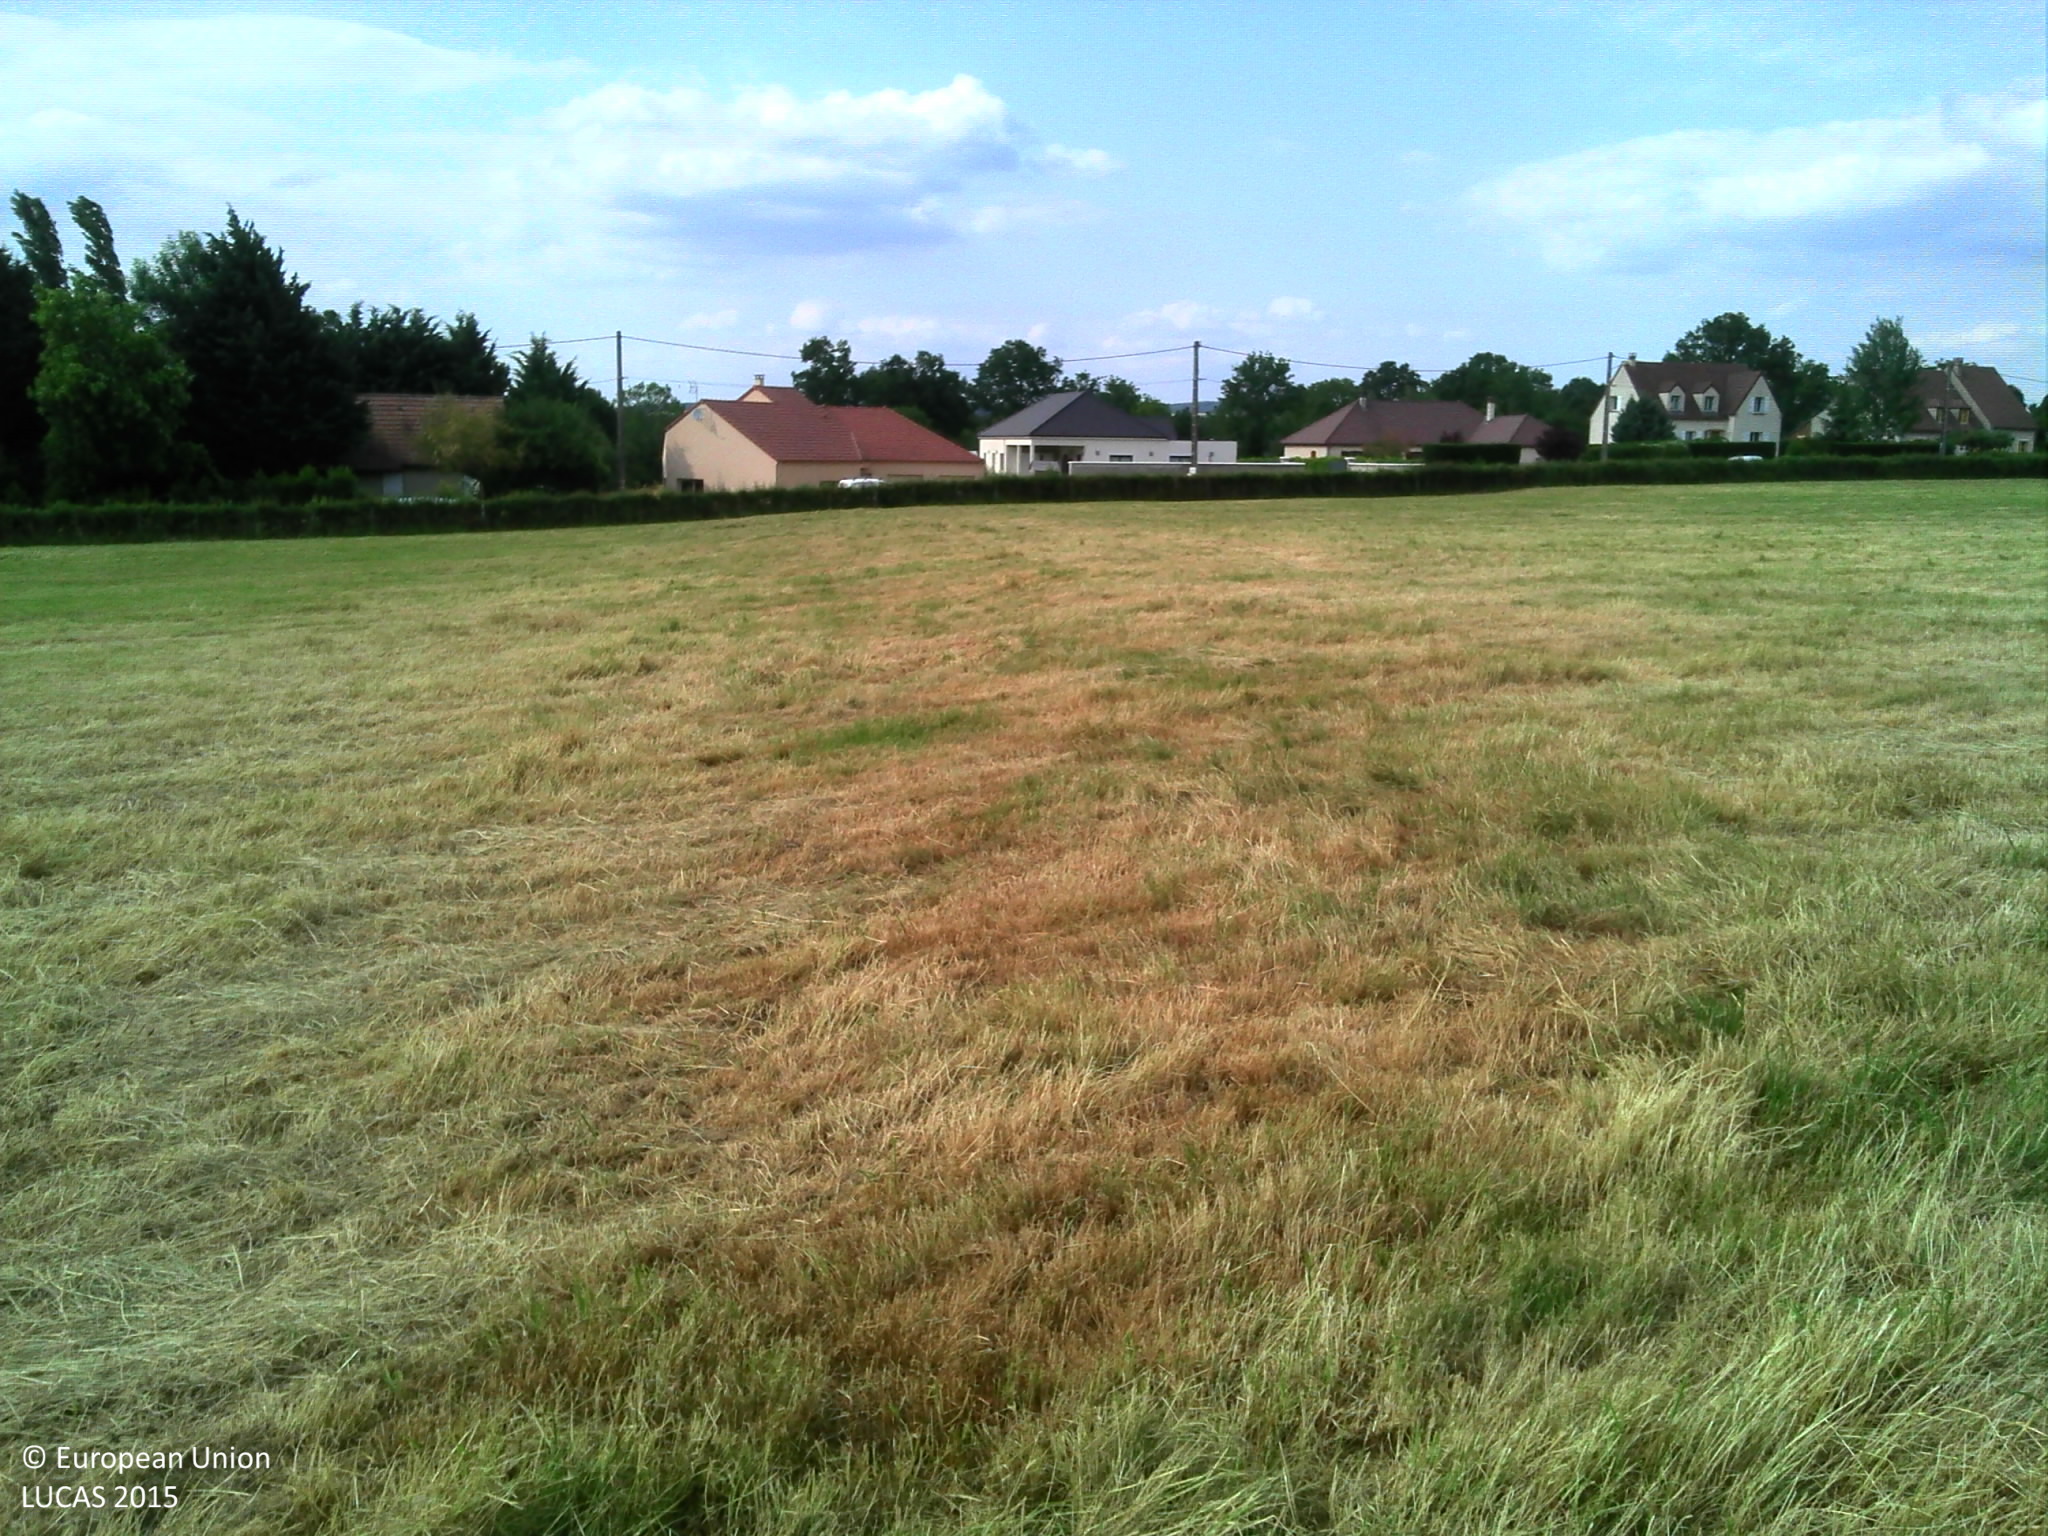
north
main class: Grassland
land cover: Grassland without tree/shrub cover
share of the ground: > 75 %
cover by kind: herbaceous plants 100 %
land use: Agriculture (excluding fallow land and kitchen gardens)
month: June
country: FR
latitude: 47.4939
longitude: 3.8783
